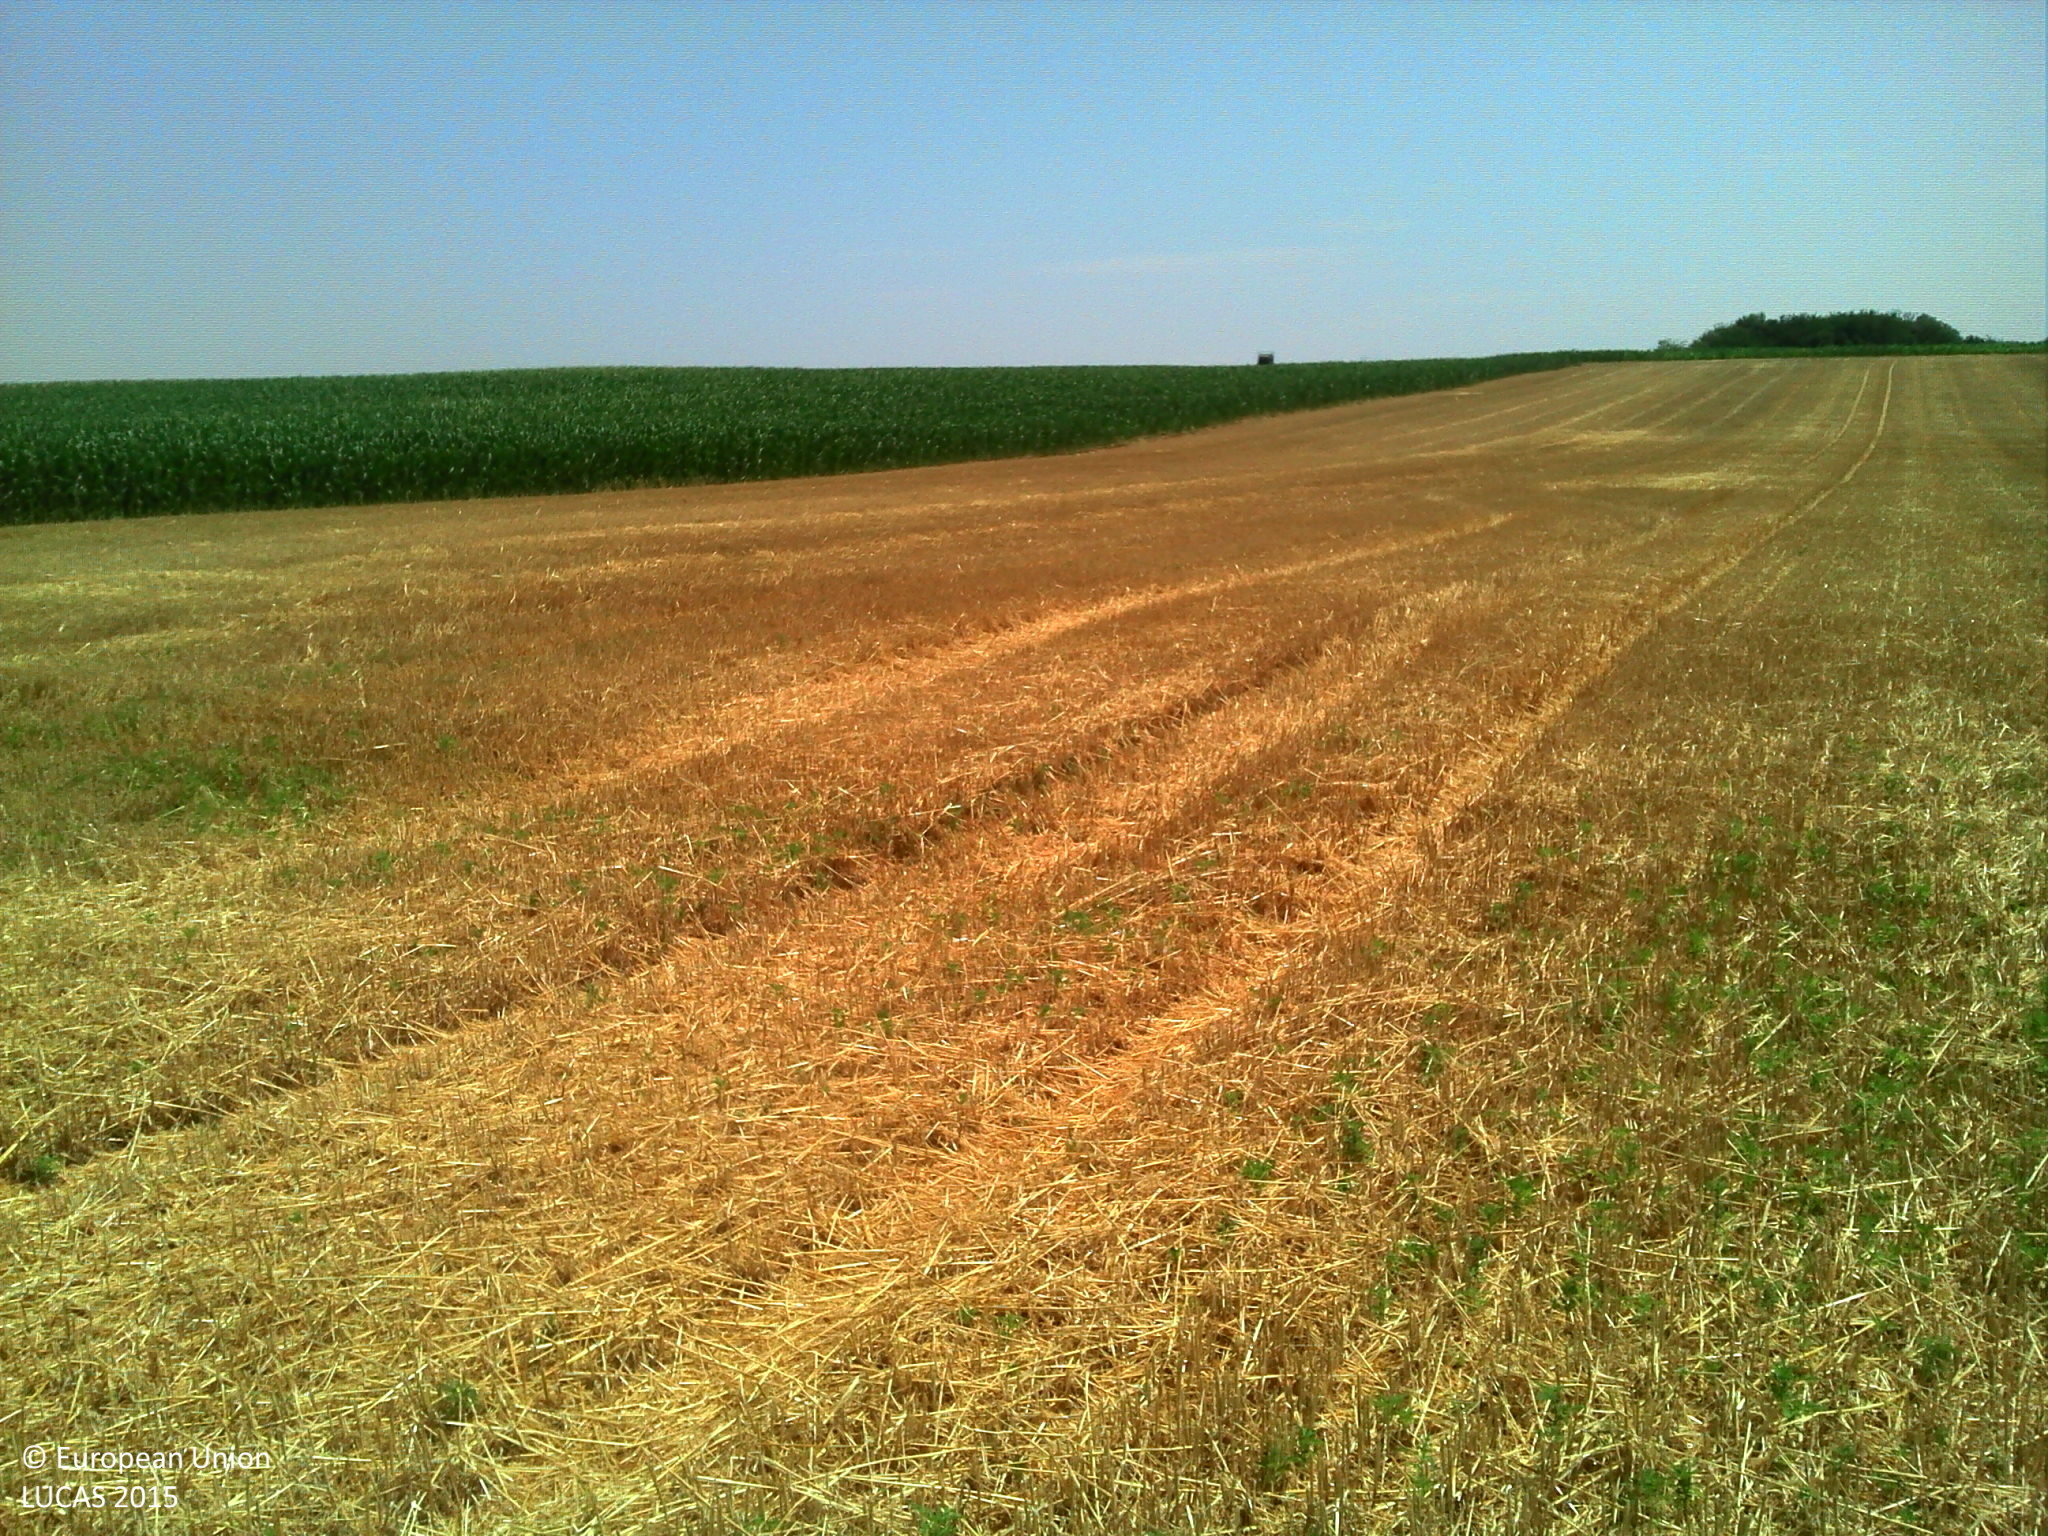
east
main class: Cropland
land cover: Durum wheat
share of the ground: < 10 %
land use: Agriculture (excluding fallow land and kitchen gardens)
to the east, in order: Durum wheat; Maize; Tracks
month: July
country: FR
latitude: 45.3565
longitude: 5.1412
